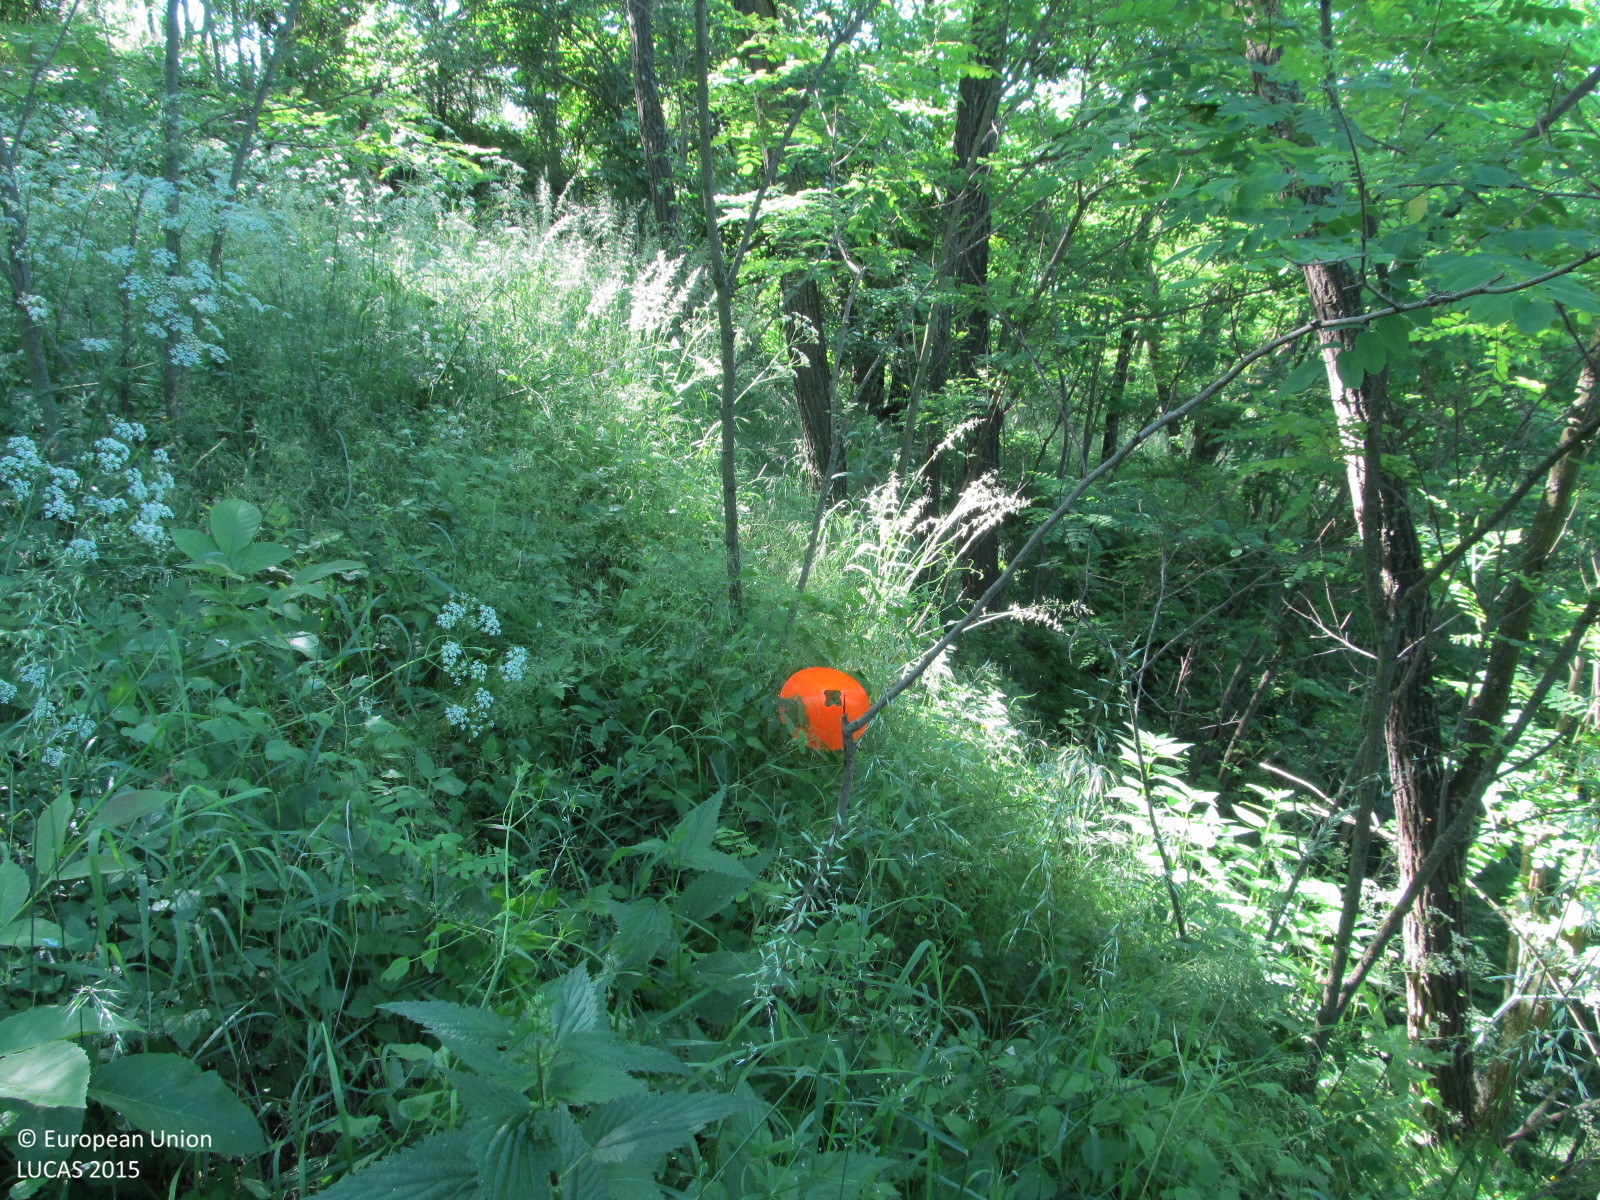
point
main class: Woodland
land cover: Broadleaved woodland
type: mesophytic deciduous forest
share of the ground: > 75 %
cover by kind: broadleaved forest trees 75 %, shrubs 15 %, herbaceous plants 10 %
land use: Semi-natural and natural areas not in use
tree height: > 5 m
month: June
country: AT
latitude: 48.4976
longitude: 15.9179
